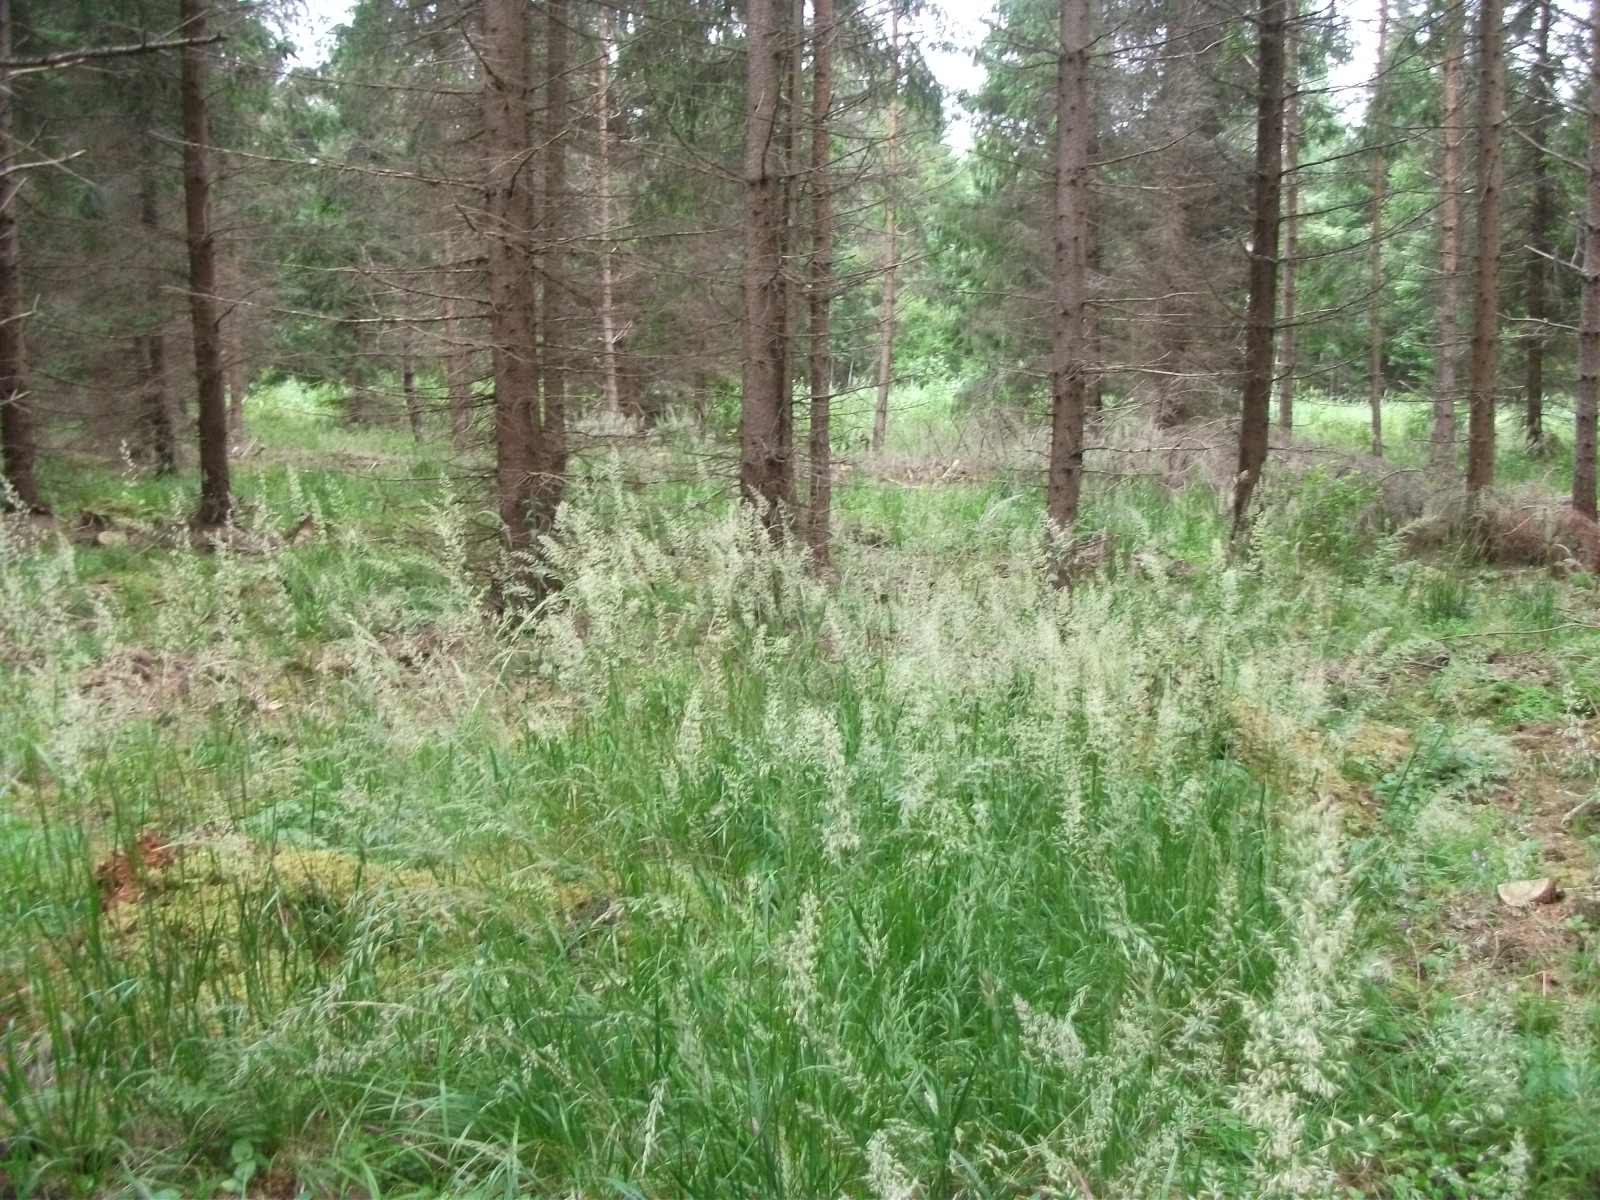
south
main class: Woodland
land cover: Spruce dominated coniferous woodland
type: hemiboreal forest and nemoral coniferous forest and mixed broadleaved-coniferous forest
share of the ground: > 75 %
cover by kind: coniferous forest trees 75 %, herbaceous plants 15 %, lichens and mosses 10 %
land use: Forestry
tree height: > 5 m
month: July
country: LV
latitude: 57.1915
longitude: 26.4764
